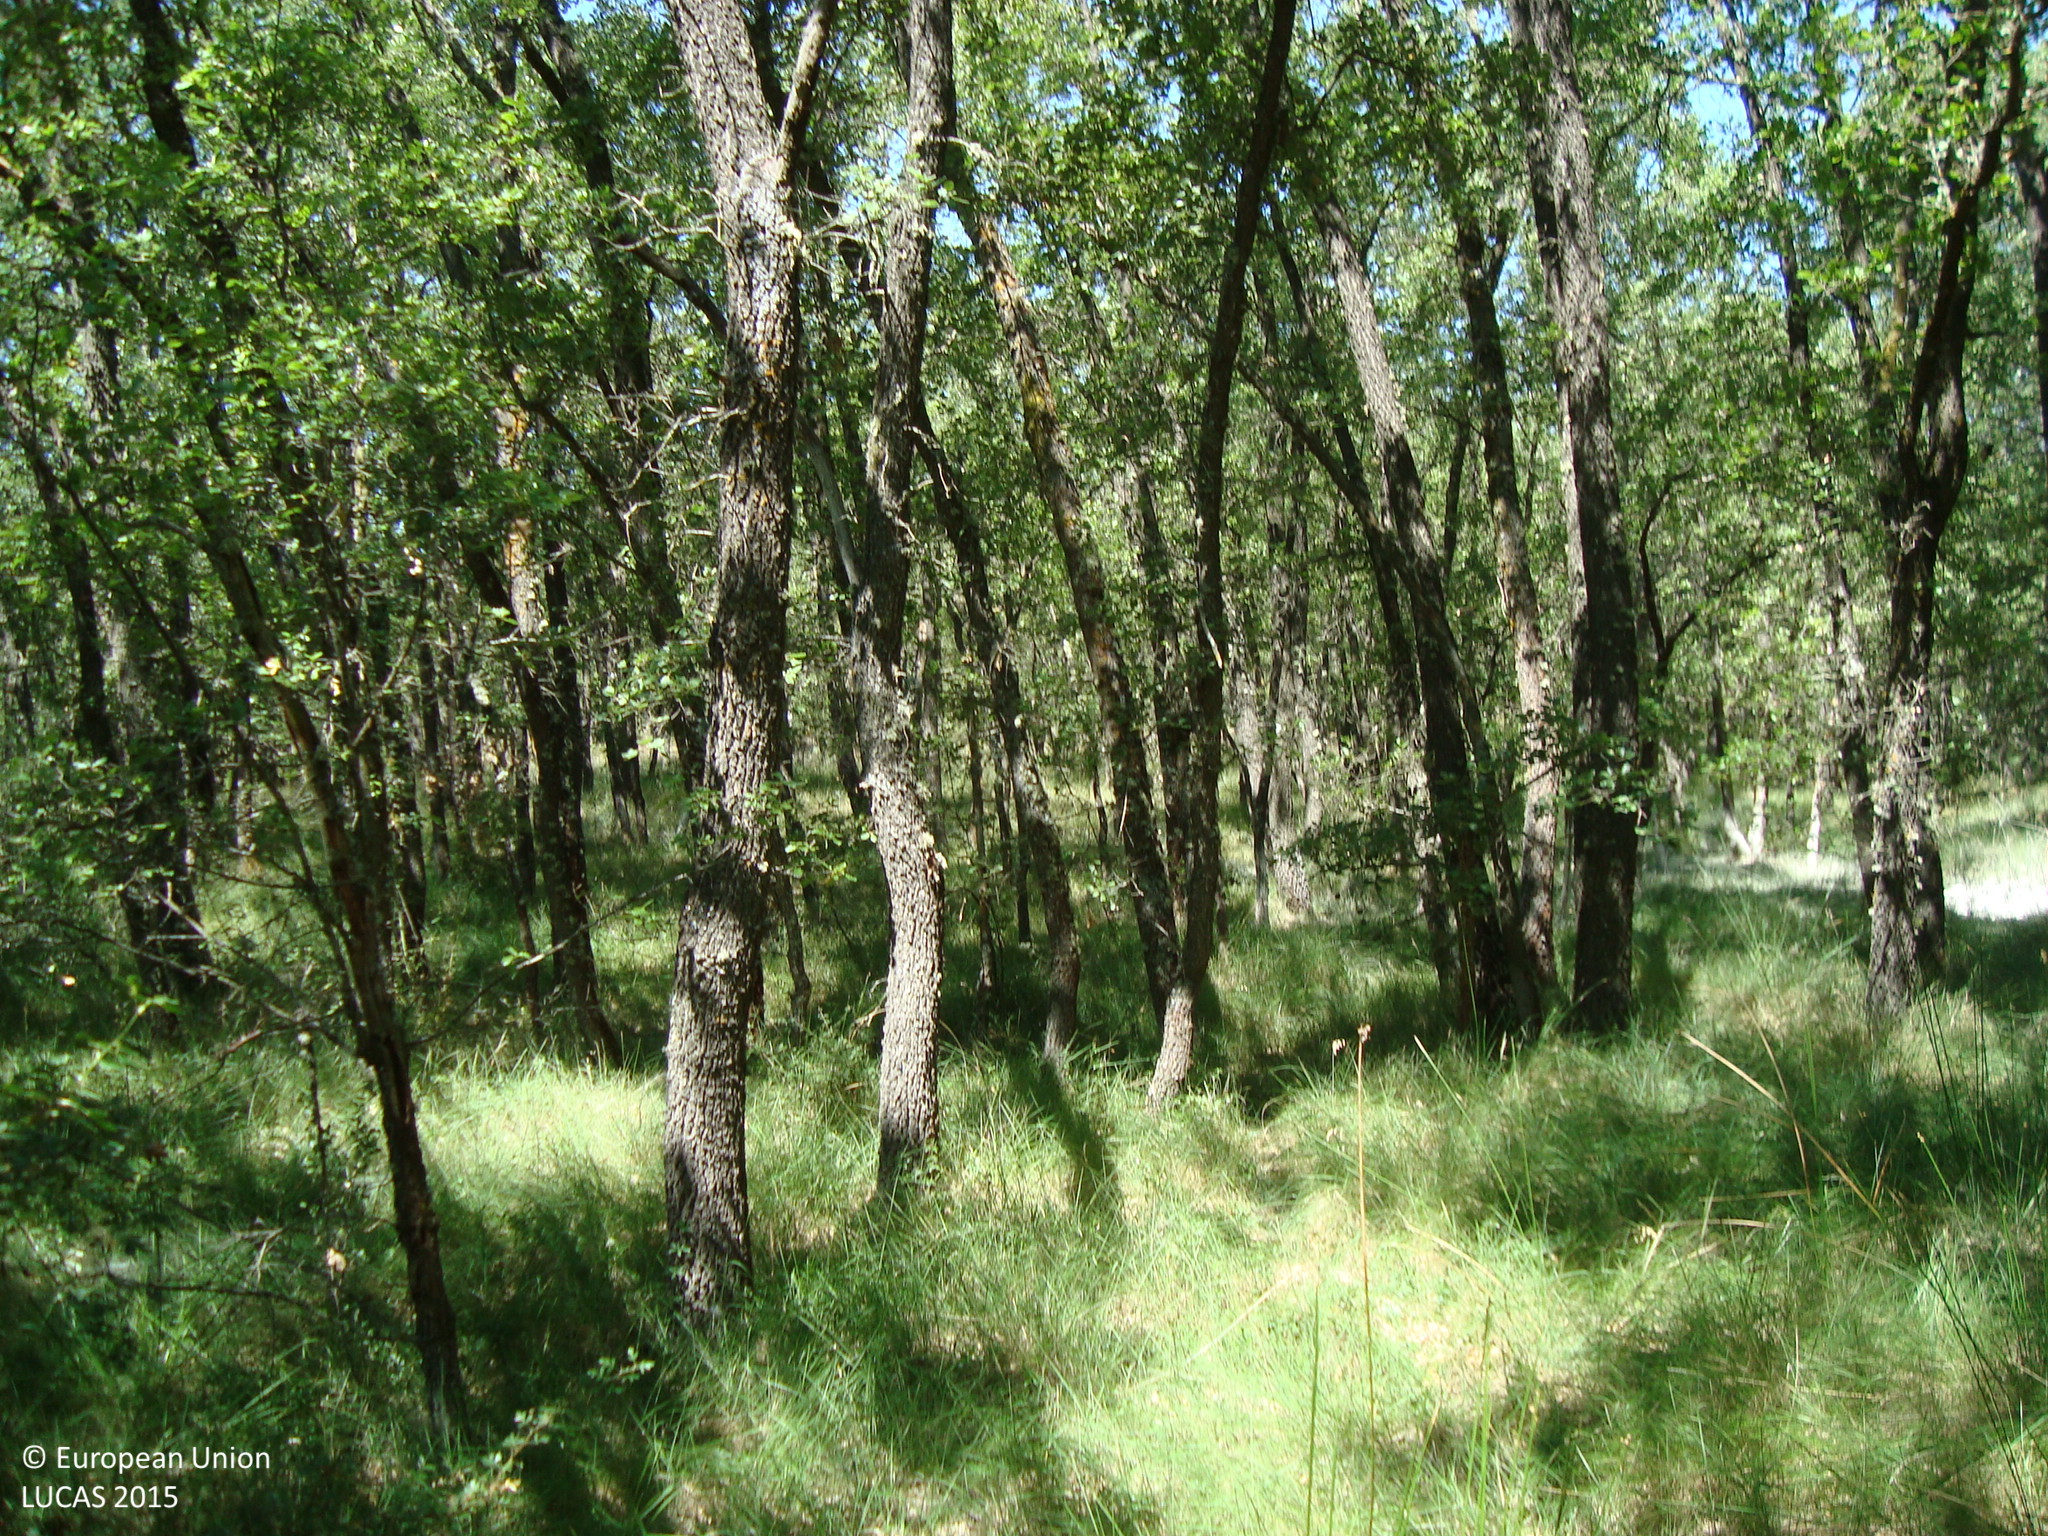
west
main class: Woodland
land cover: Broadleaved woodland
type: thermophilous deciduous forest
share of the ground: > 75 %
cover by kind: broadleaved forest trees 80 %, herbaceous plants 20 %
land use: Forestry
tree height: > 5 m
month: July
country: ES
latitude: 41.8260
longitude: -4.2341
